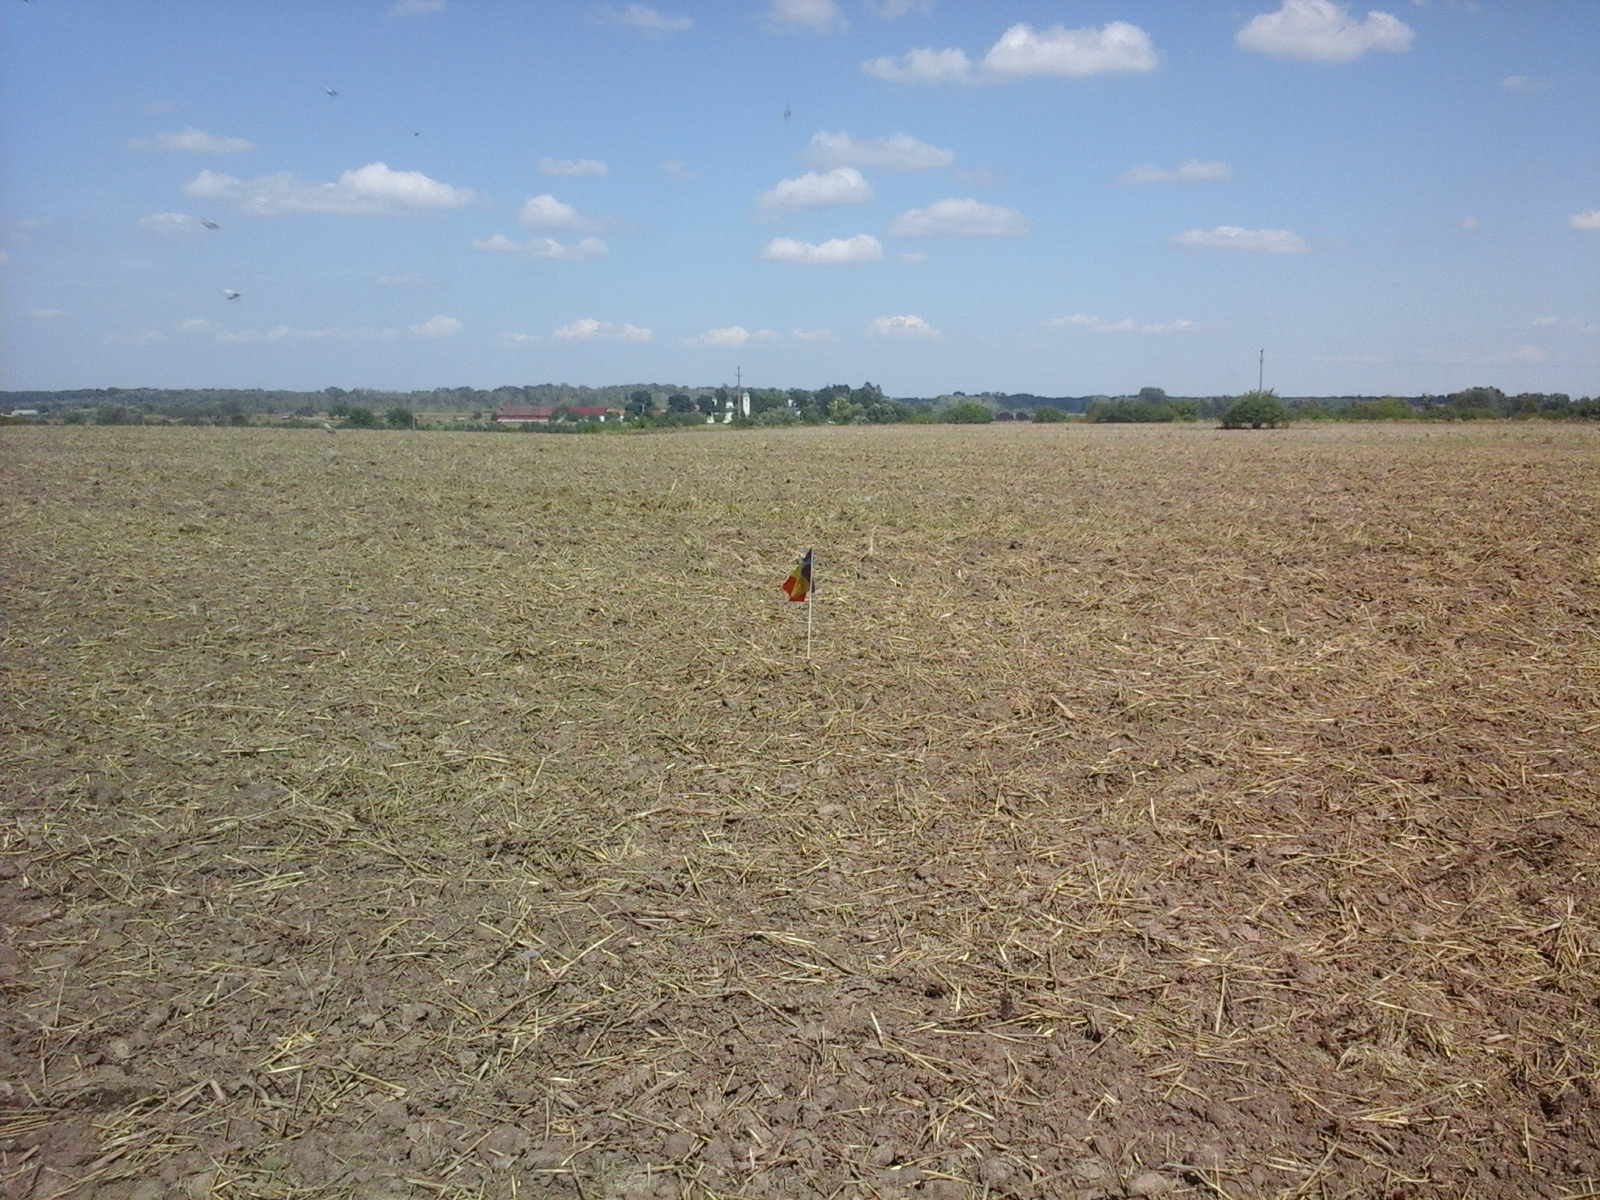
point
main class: Cropland
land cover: Common wheat
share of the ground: < 10 %
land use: Agriculture (excluding fallow land and kitchen gardens)
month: August
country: RO
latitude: 46.1272
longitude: 21.1751
